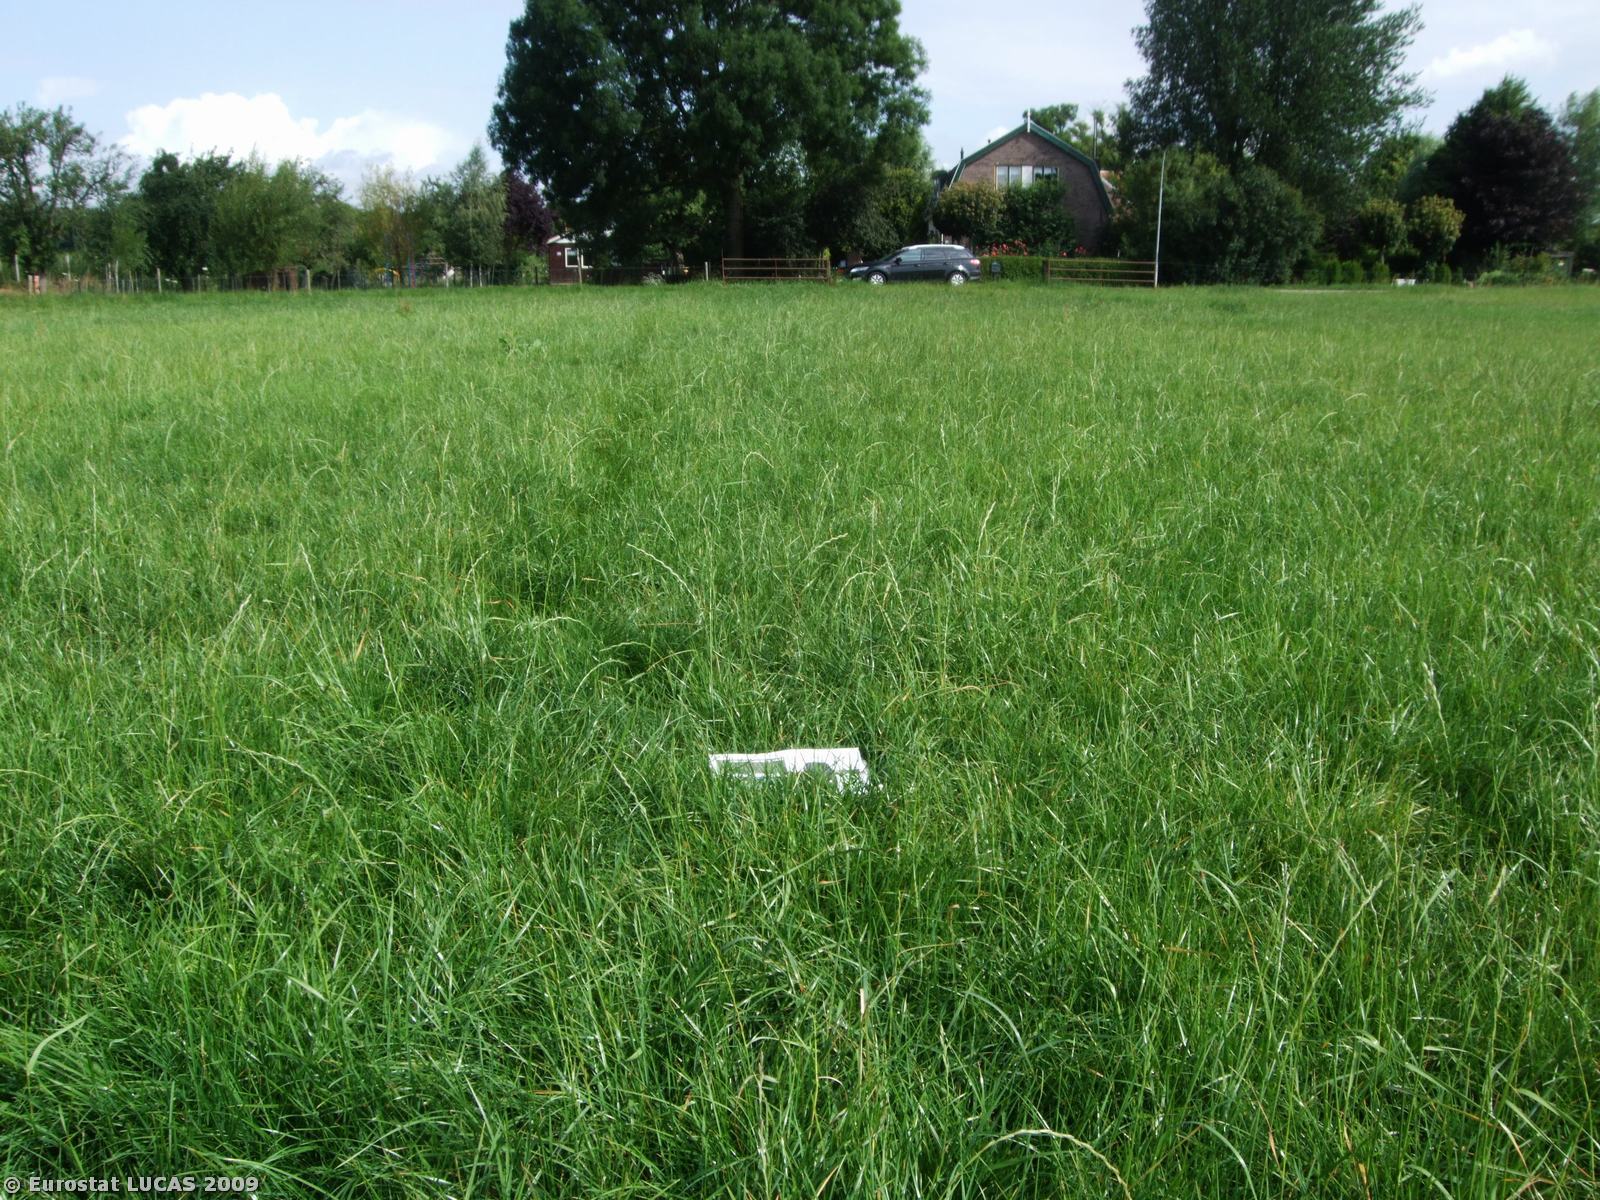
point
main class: Grassland
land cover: Grassland without tree/shrub cover
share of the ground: > 75 %
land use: Agriculture (excluding fallow land and kitchen gardens)
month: July
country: NL
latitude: 51.9458
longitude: 5.3863
